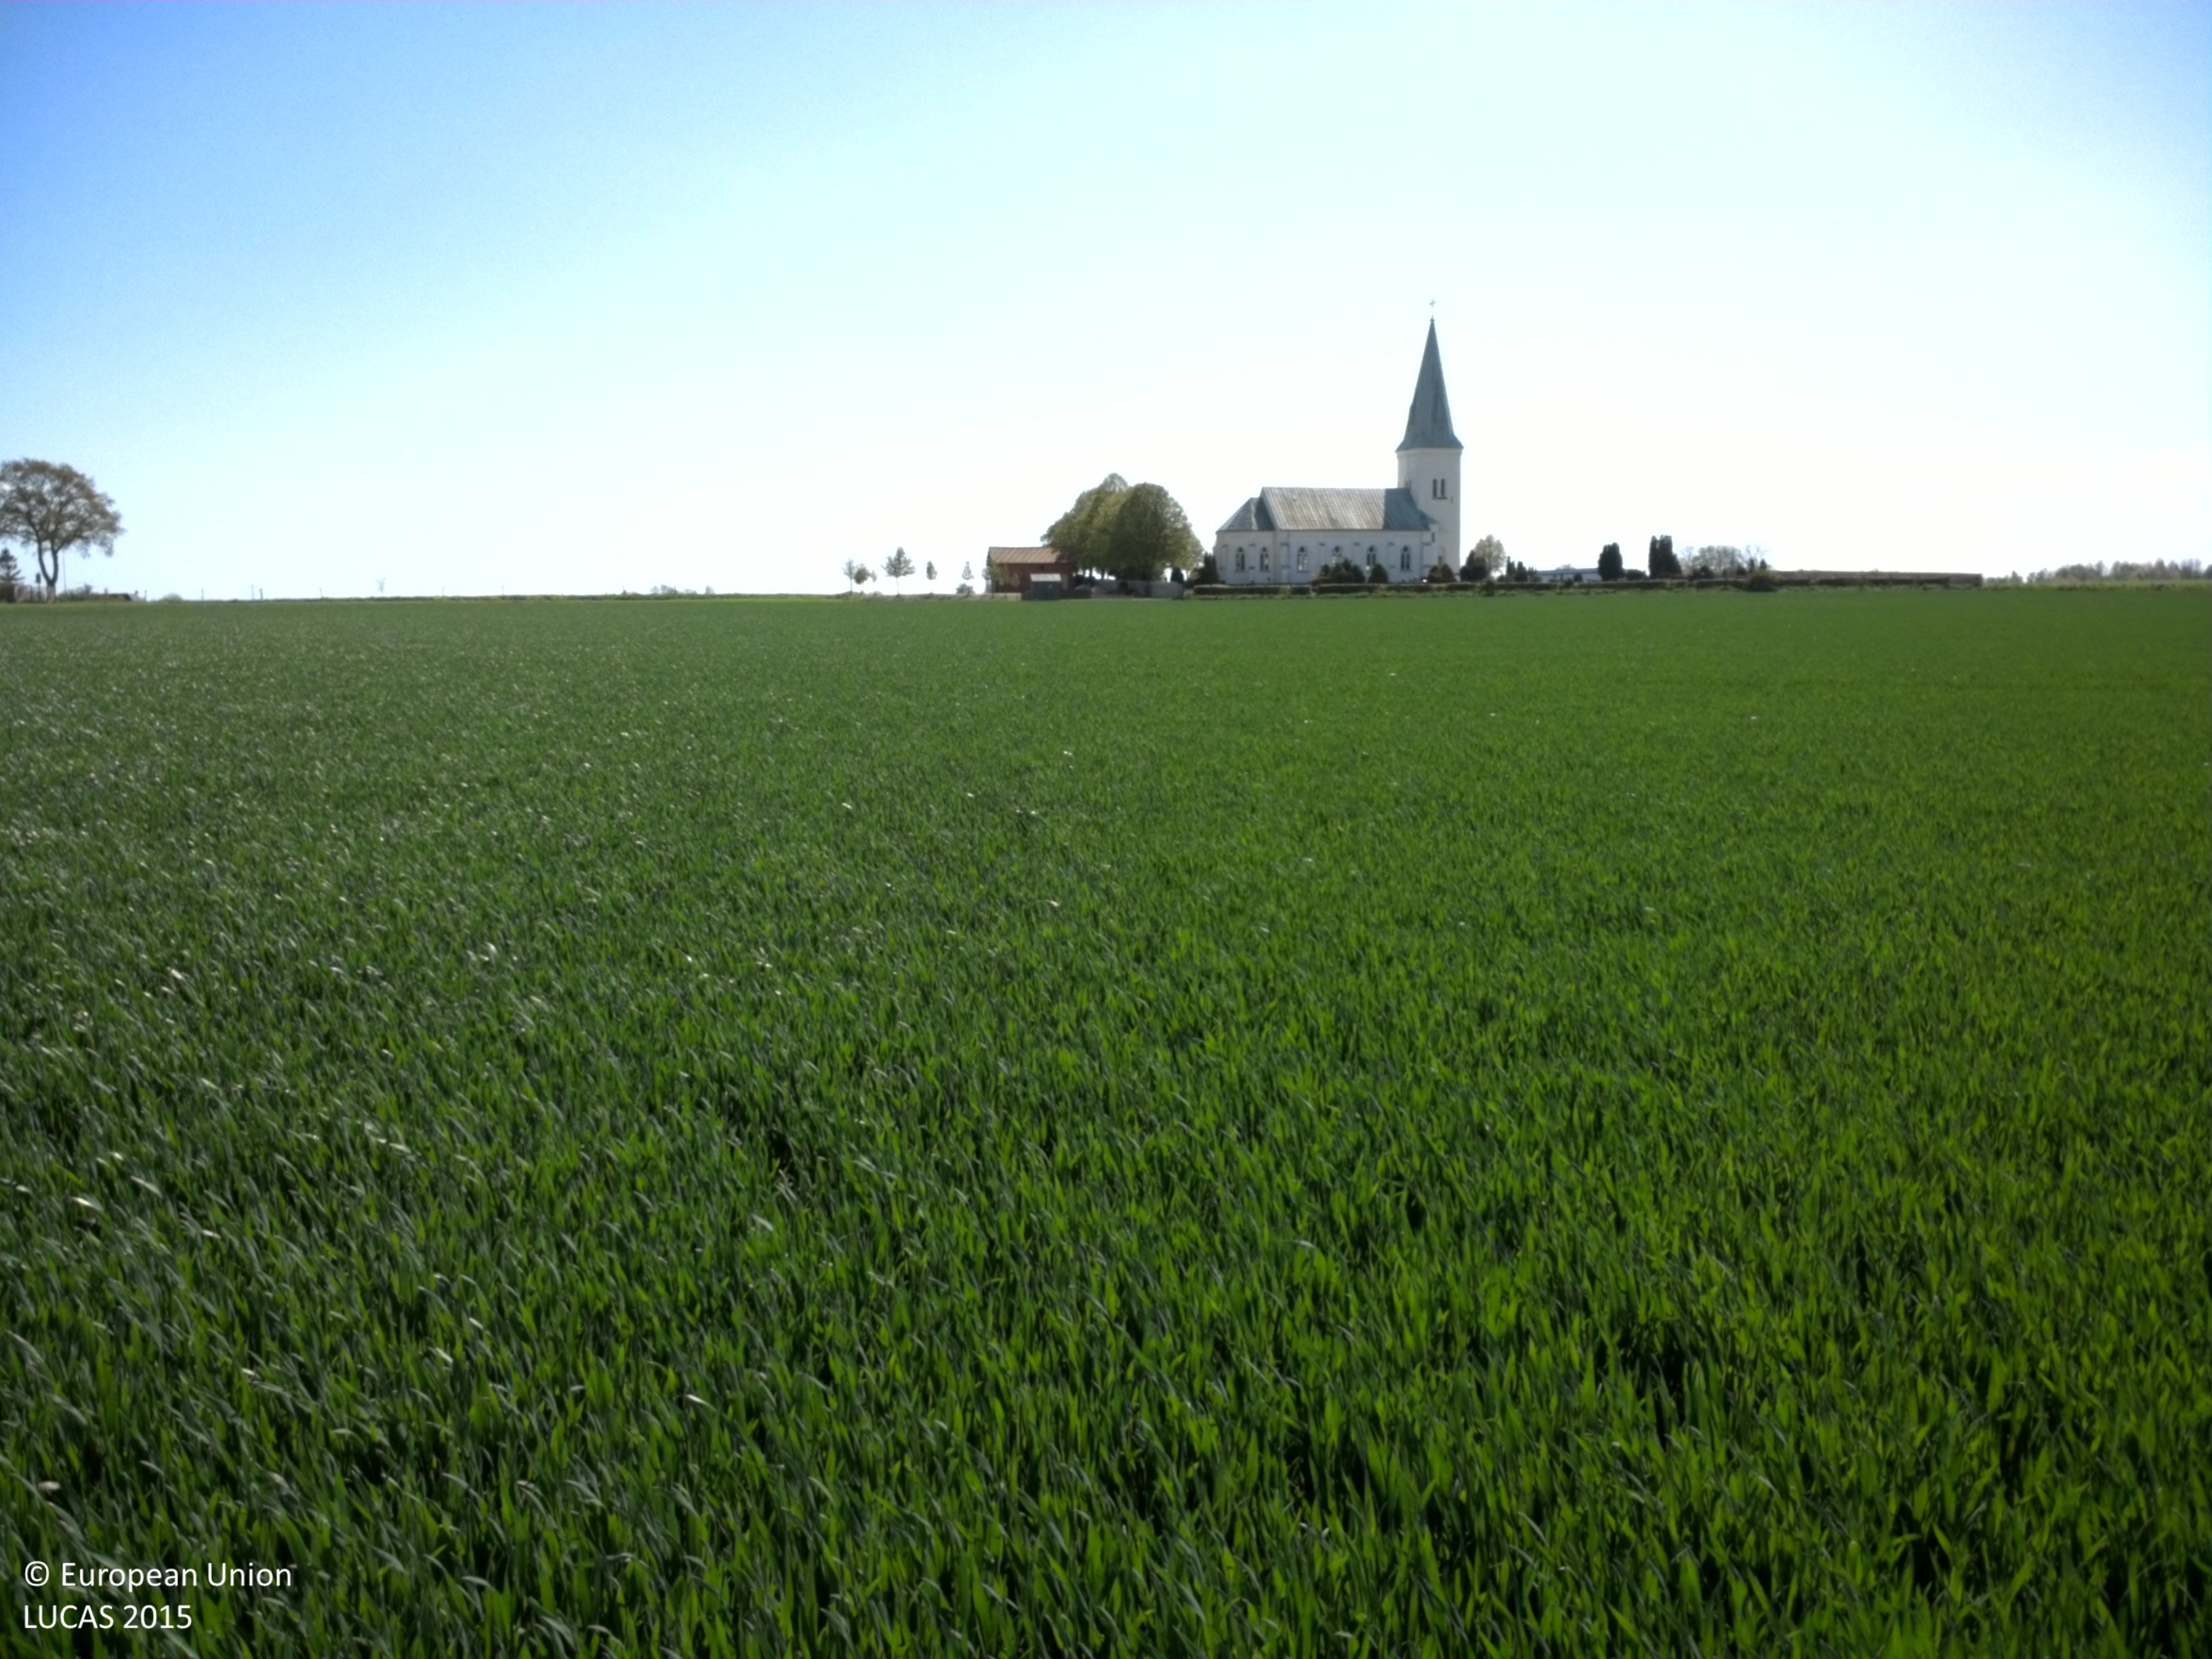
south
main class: Cropland
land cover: Common wheat
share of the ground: > 75 %
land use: Agriculture (excluding fallow land and kitchen gardens)
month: May
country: SE
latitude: 55.4859
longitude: 13.0524
